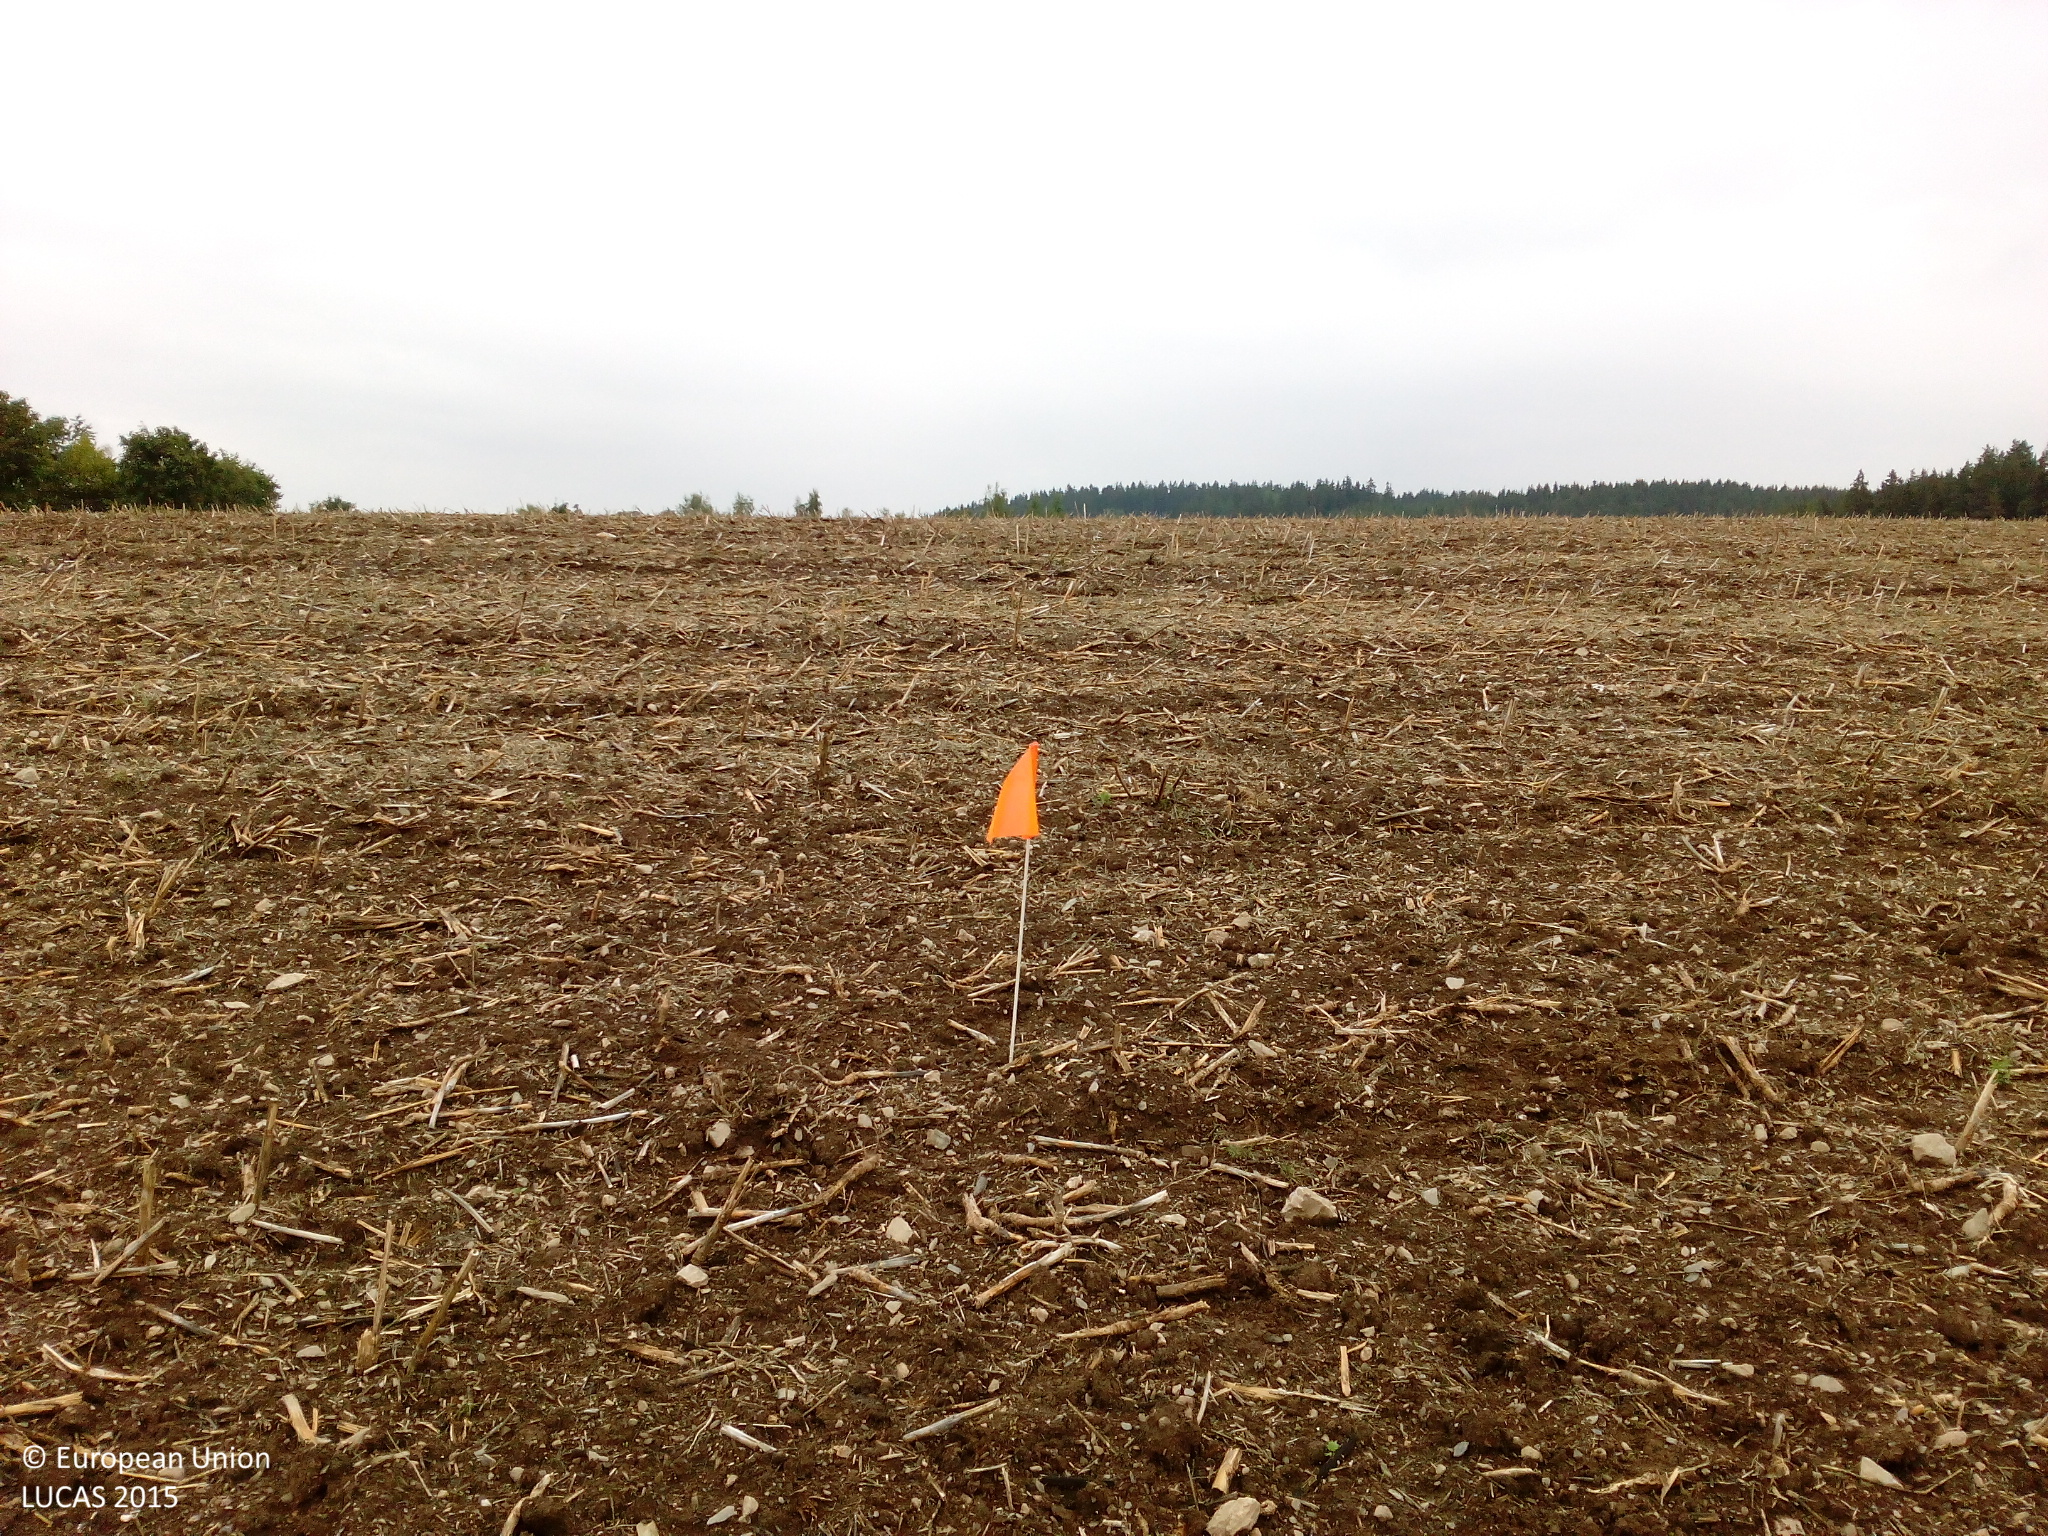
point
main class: Cropland
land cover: Rape and turnip rape
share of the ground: < 10 %
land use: Agriculture (excluding fallow land and kitchen gardens)
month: August
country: DE
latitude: 50.2211
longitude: 11.9758
